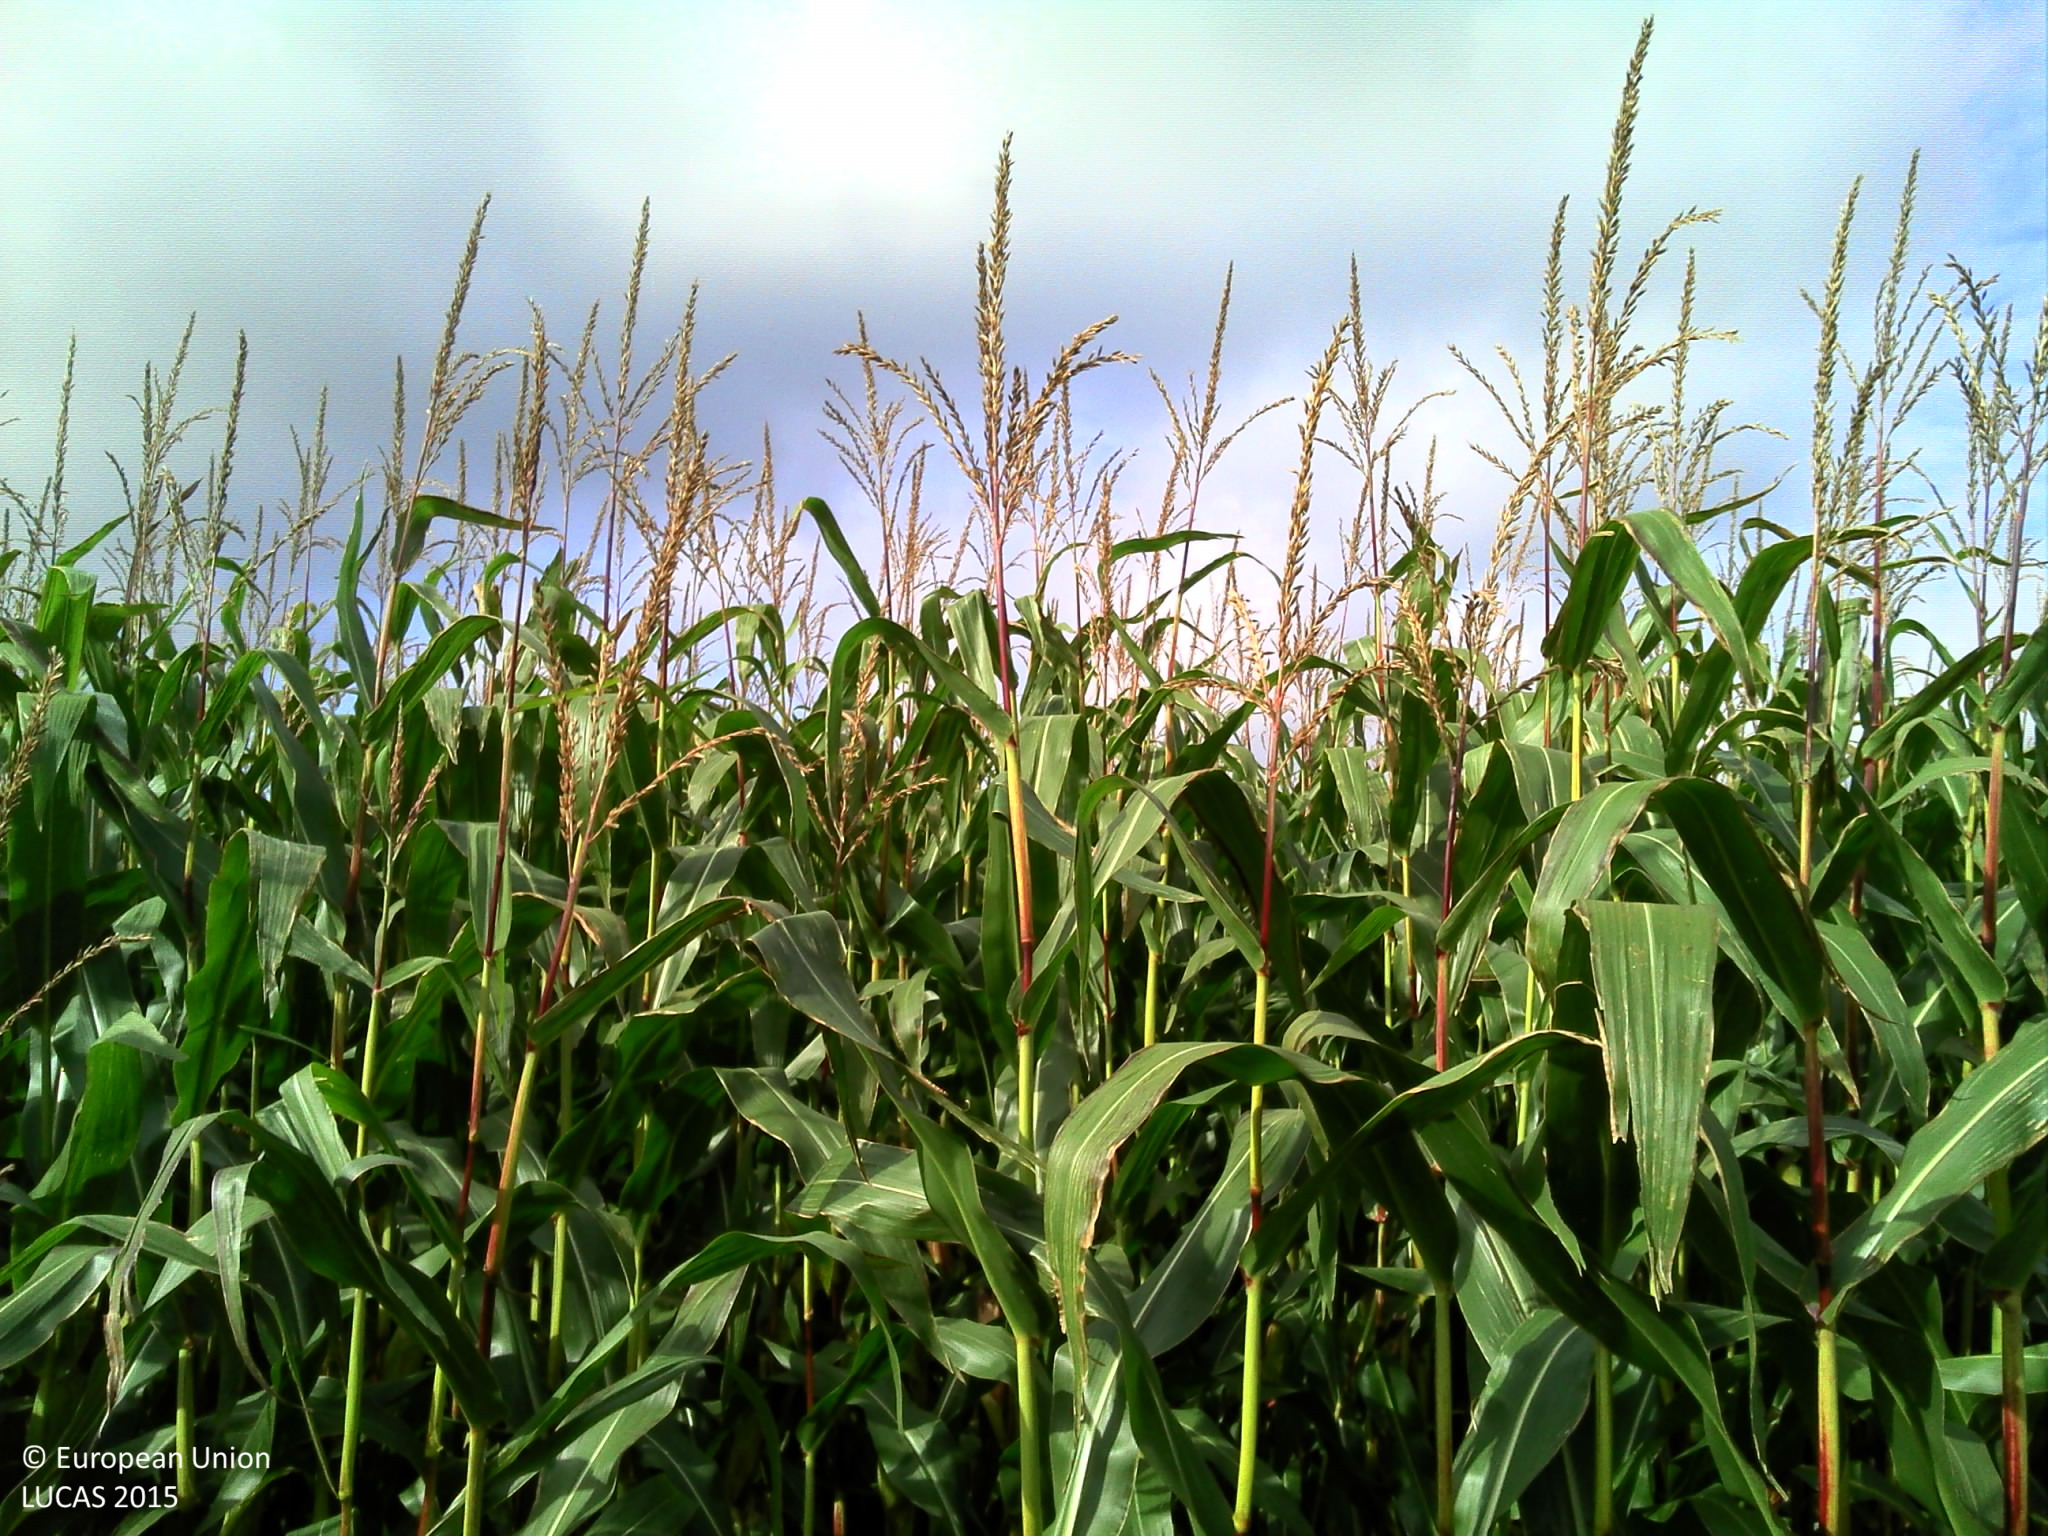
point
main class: Cropland
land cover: Maize
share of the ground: > 75 %
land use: Agriculture (excluding fallow land and kitchen gardens)
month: September
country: BE
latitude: 51.1271
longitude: 4.3799
